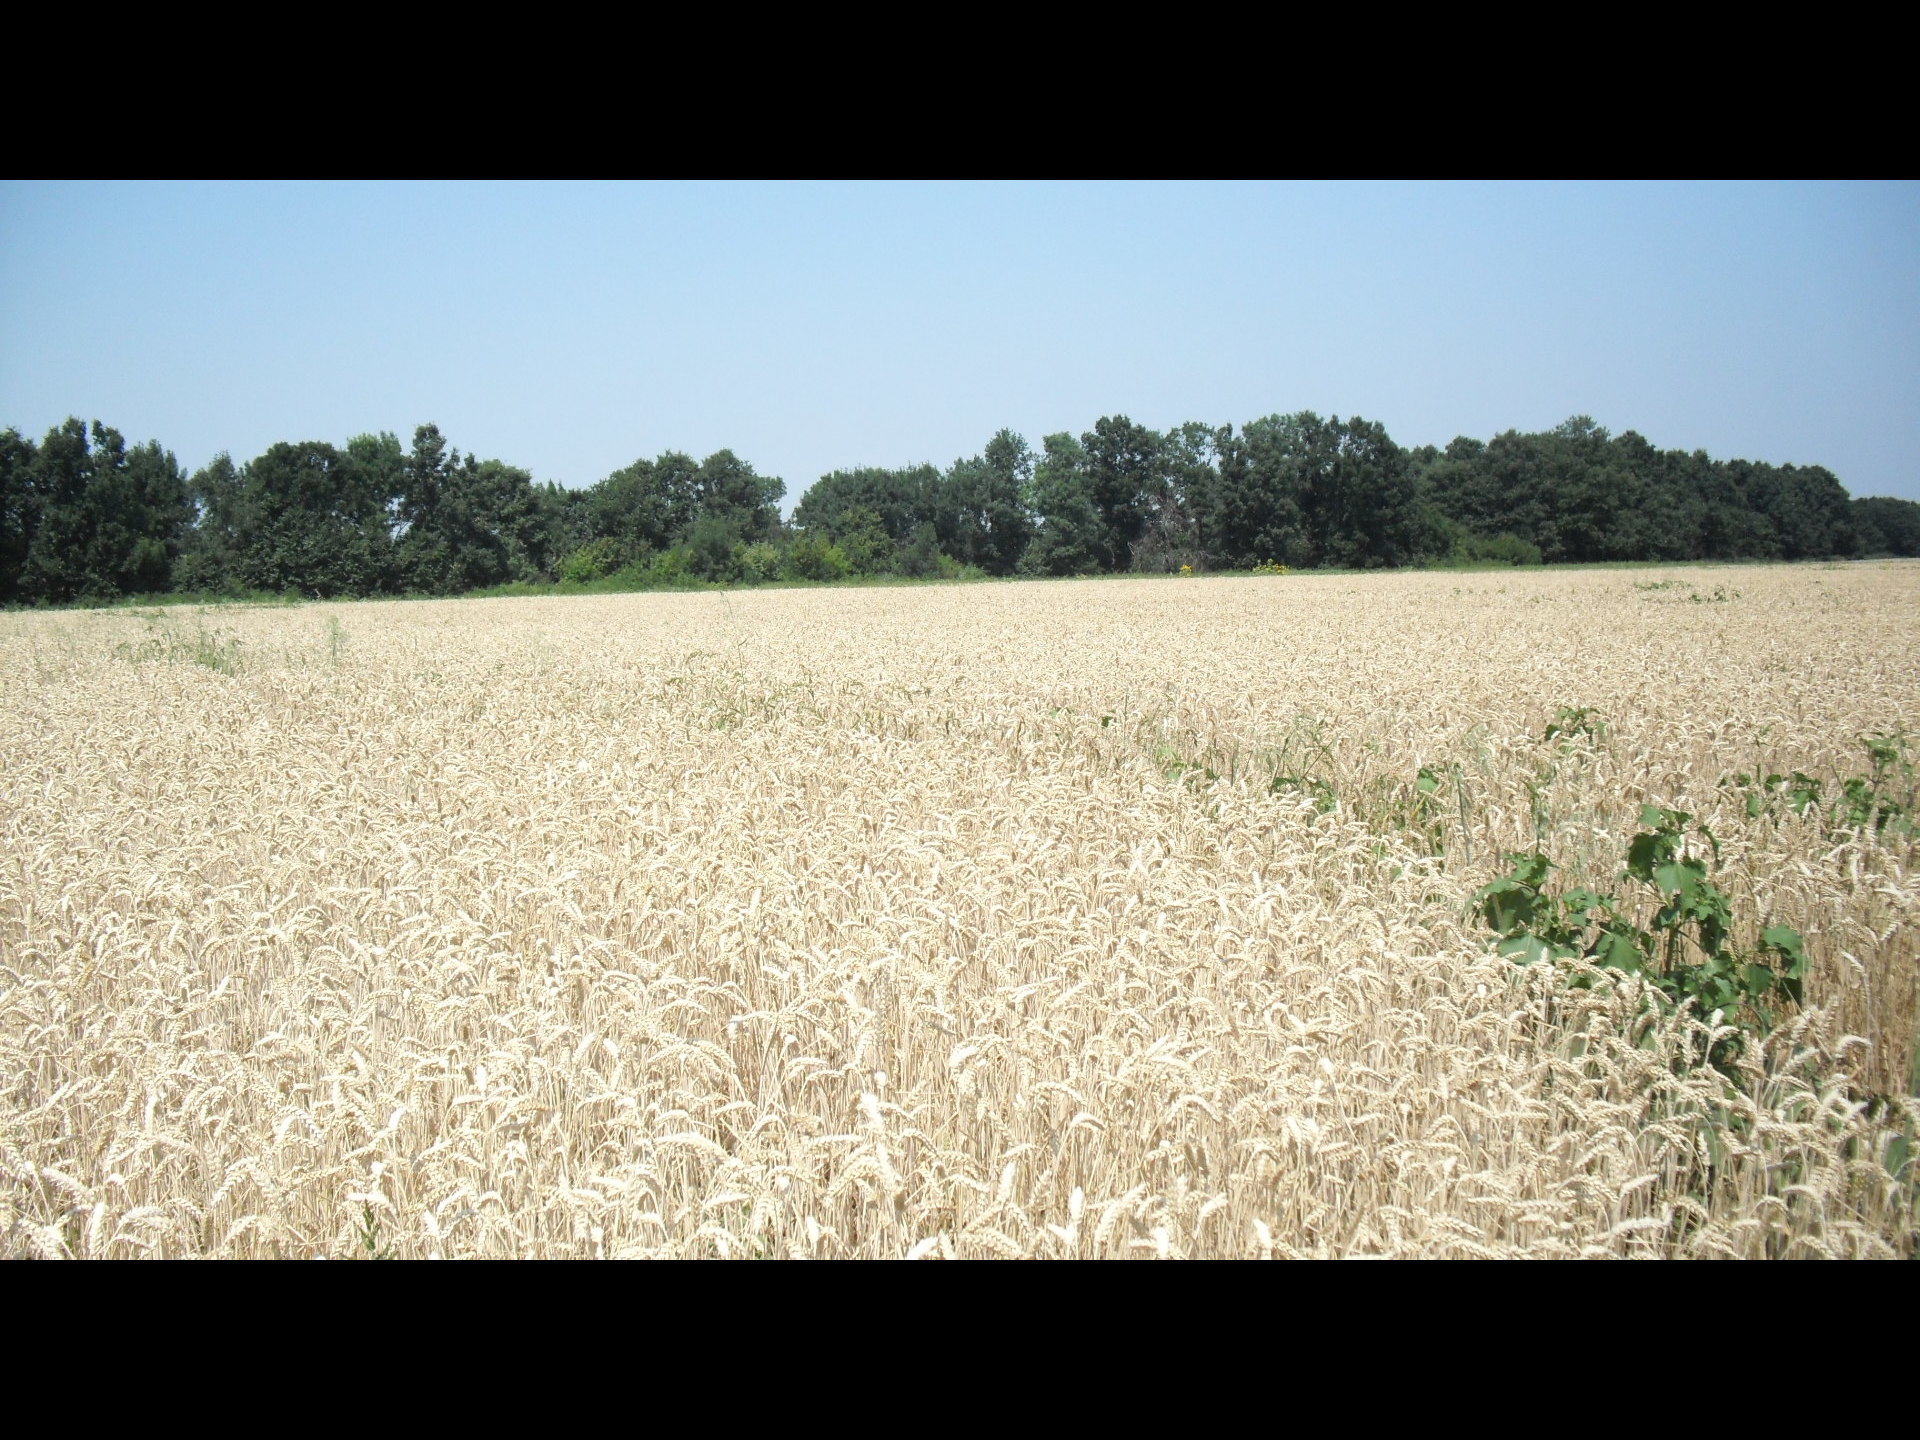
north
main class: Cropland
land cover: Common wheat
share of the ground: > 75 %
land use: Agriculture (excluding fallow land and kitchen gardens)
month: July
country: BG
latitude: 43.7081
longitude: 22.8818
